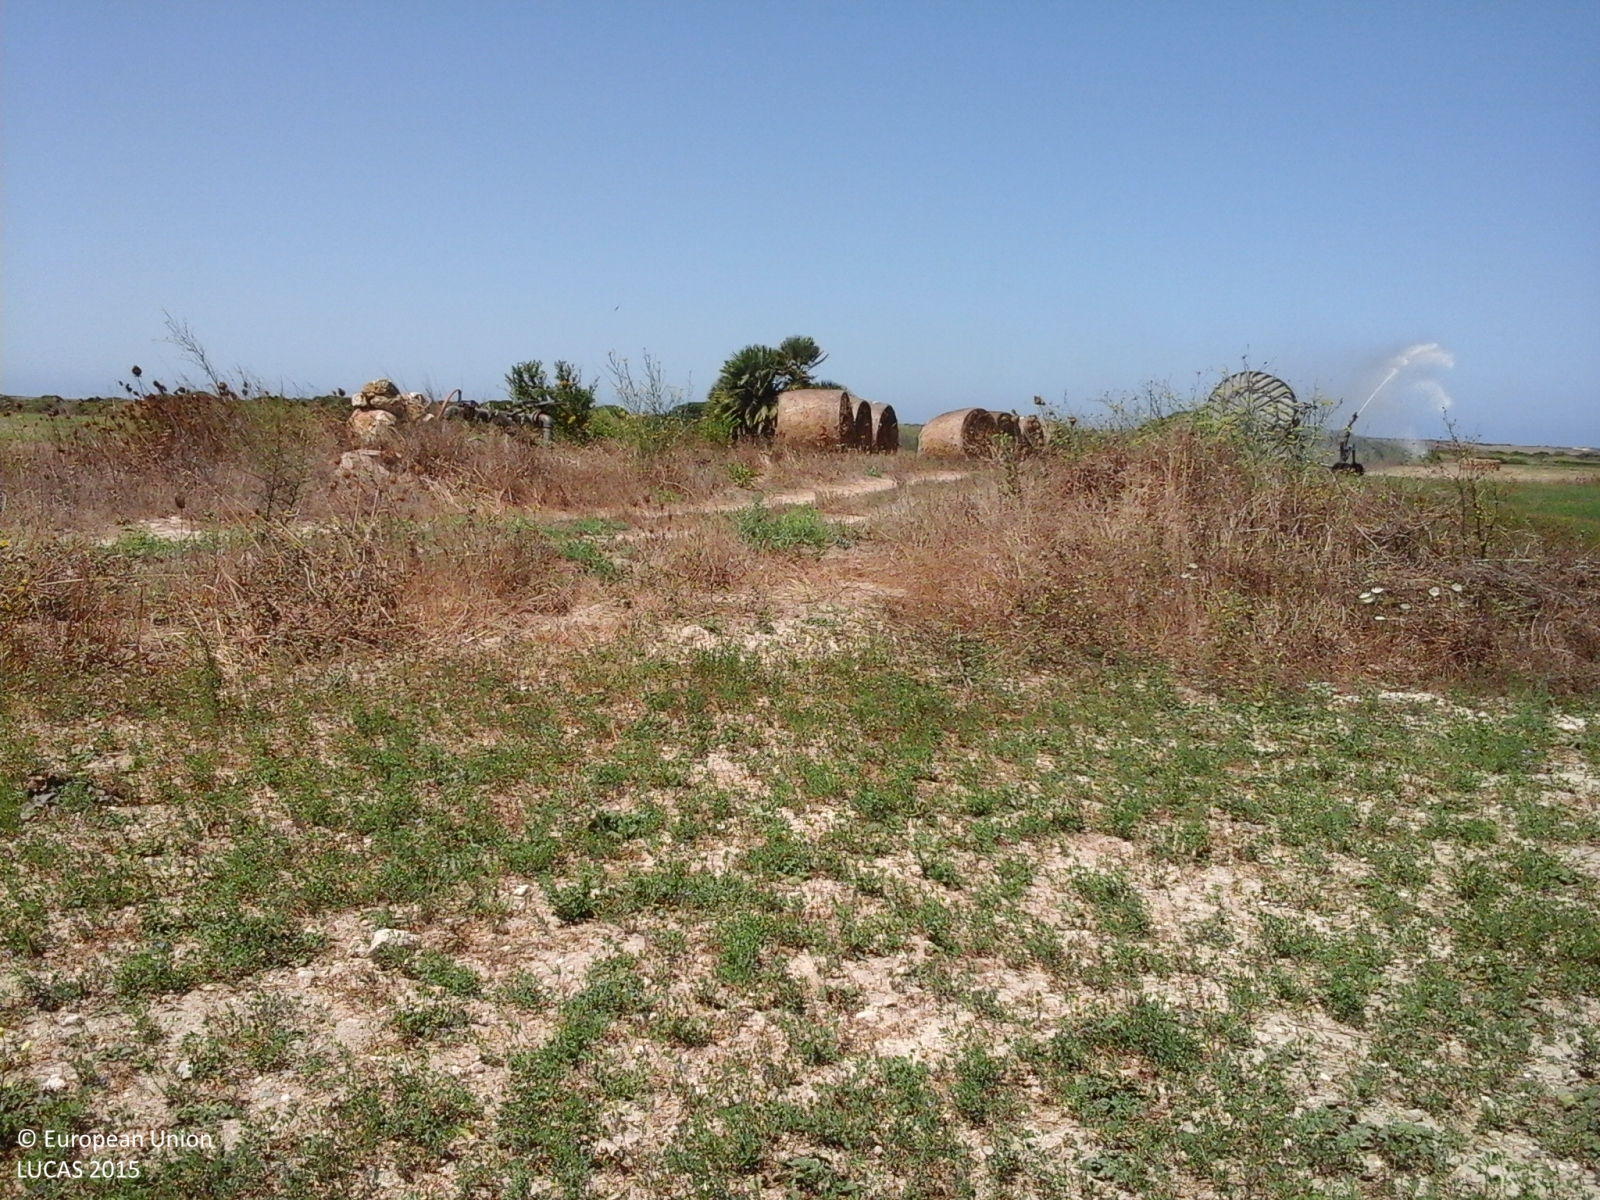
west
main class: Cropland
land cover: Lucerne
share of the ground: > 75 %
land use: Agriculture (excluding fallow land and kitchen gardens)
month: July
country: IT
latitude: 39.9831
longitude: 8.4277
